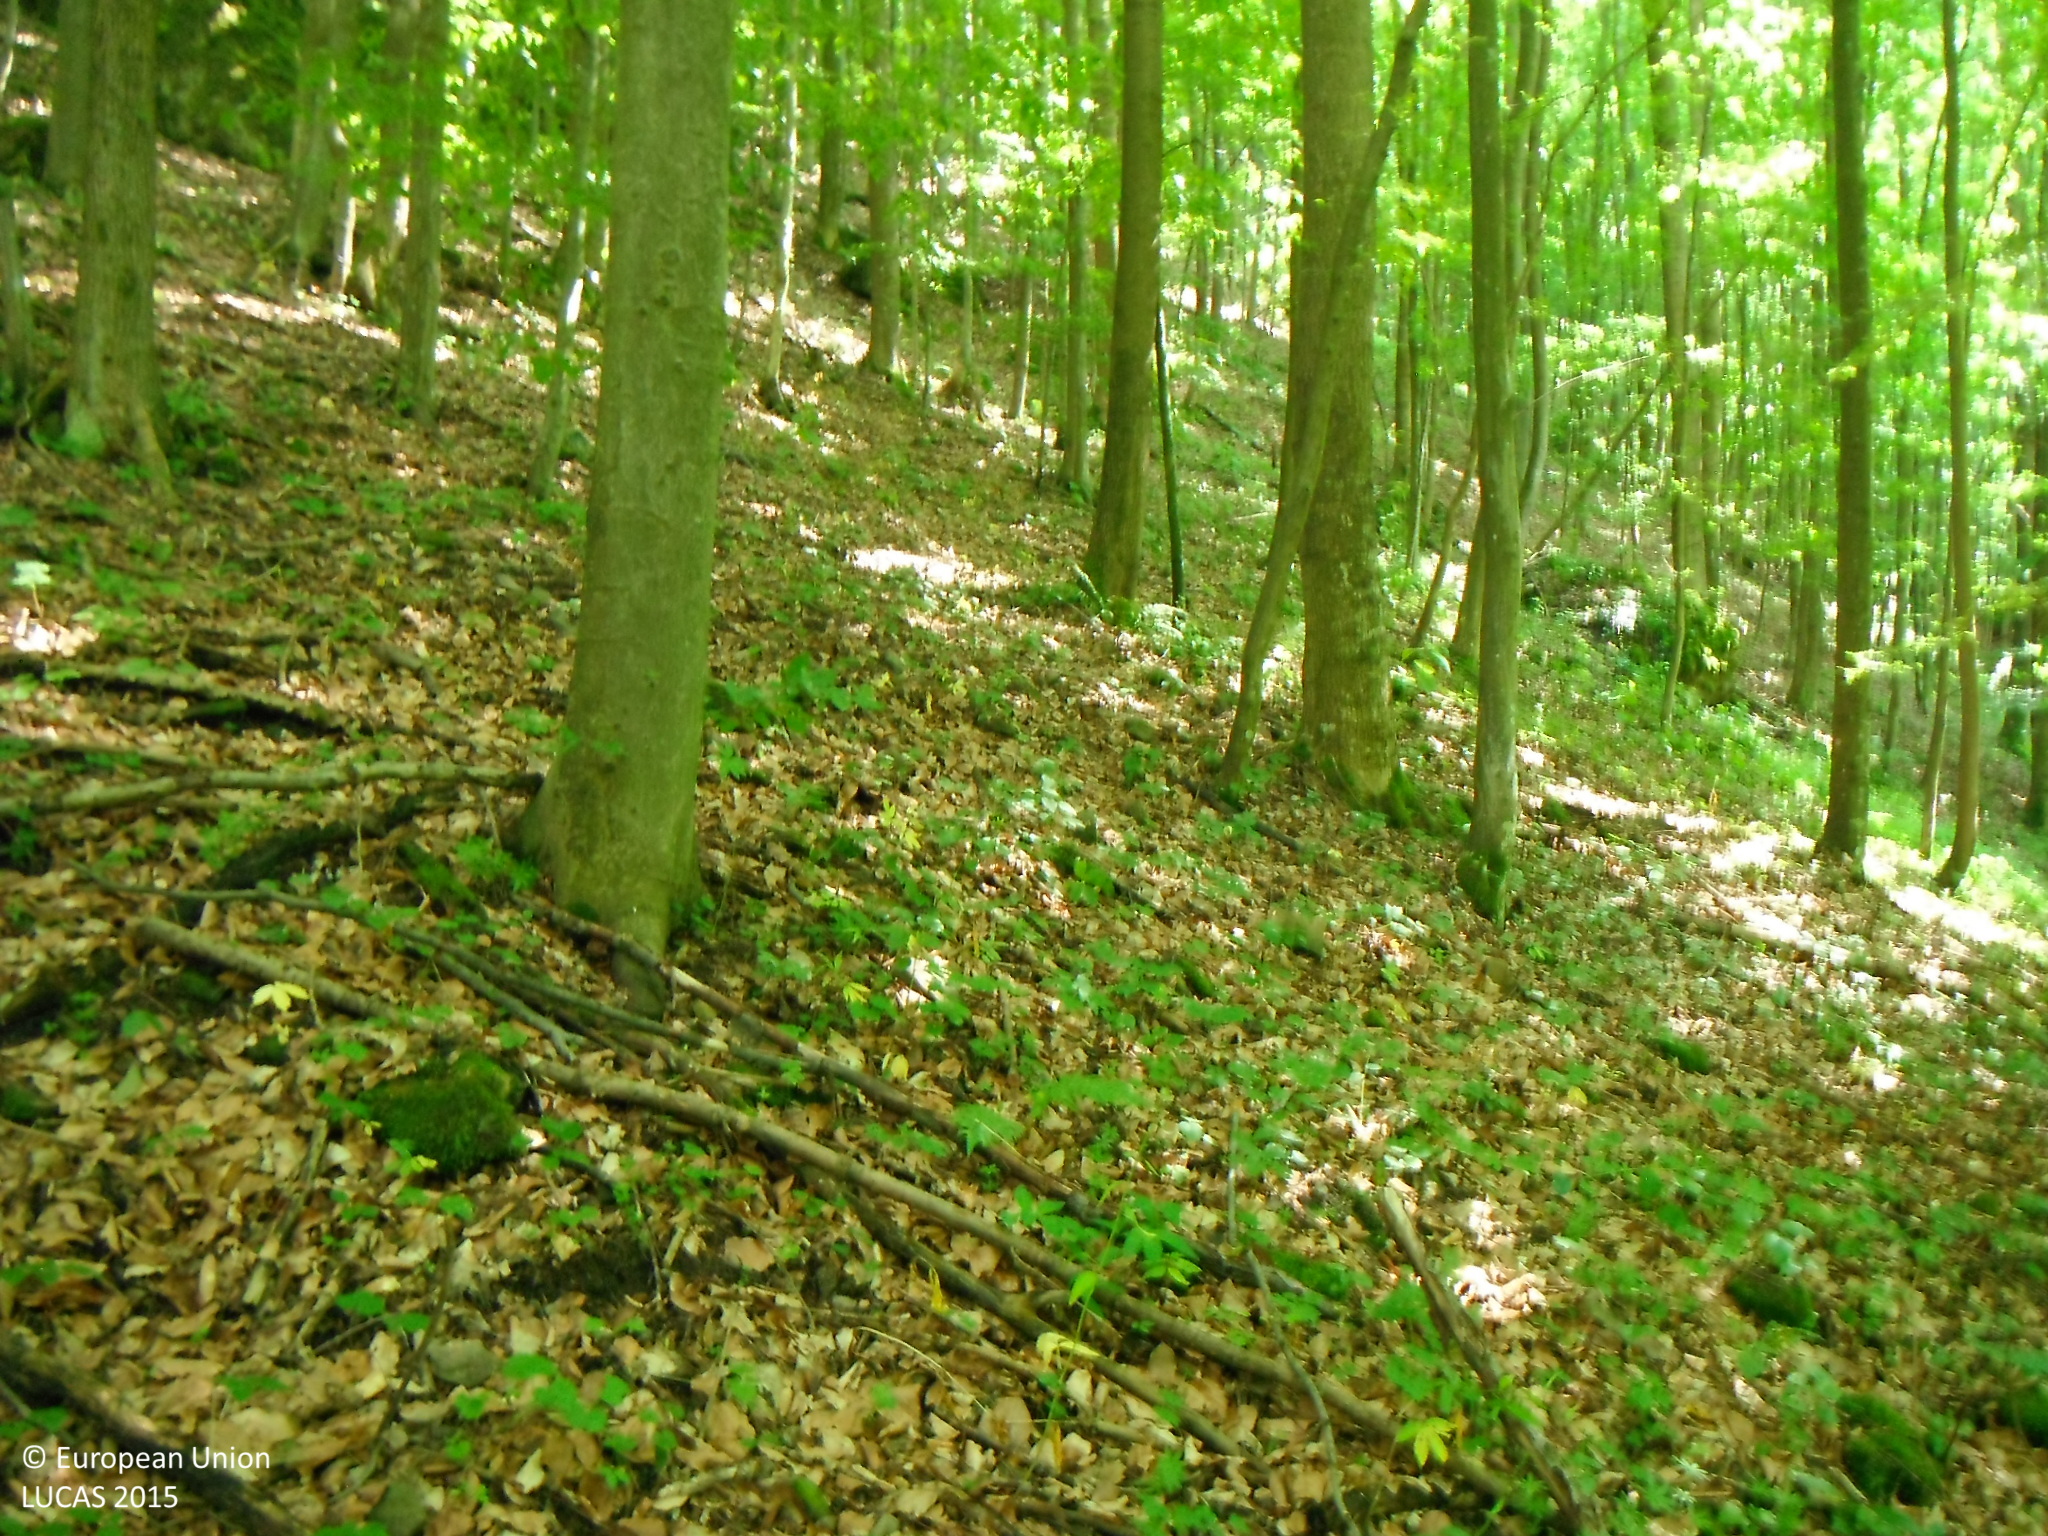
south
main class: Woodland
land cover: Other mixed woodland
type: hemiboreal forest and nemoral coniferous forest and mixed broadleaved-coniferous forest
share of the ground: > 75 %
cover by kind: coniferous forest trees 50 %, broadleaved forest trees 50 %
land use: Forestry
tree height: > 5 m
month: June
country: SK
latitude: 48.6875
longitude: 19.0000
